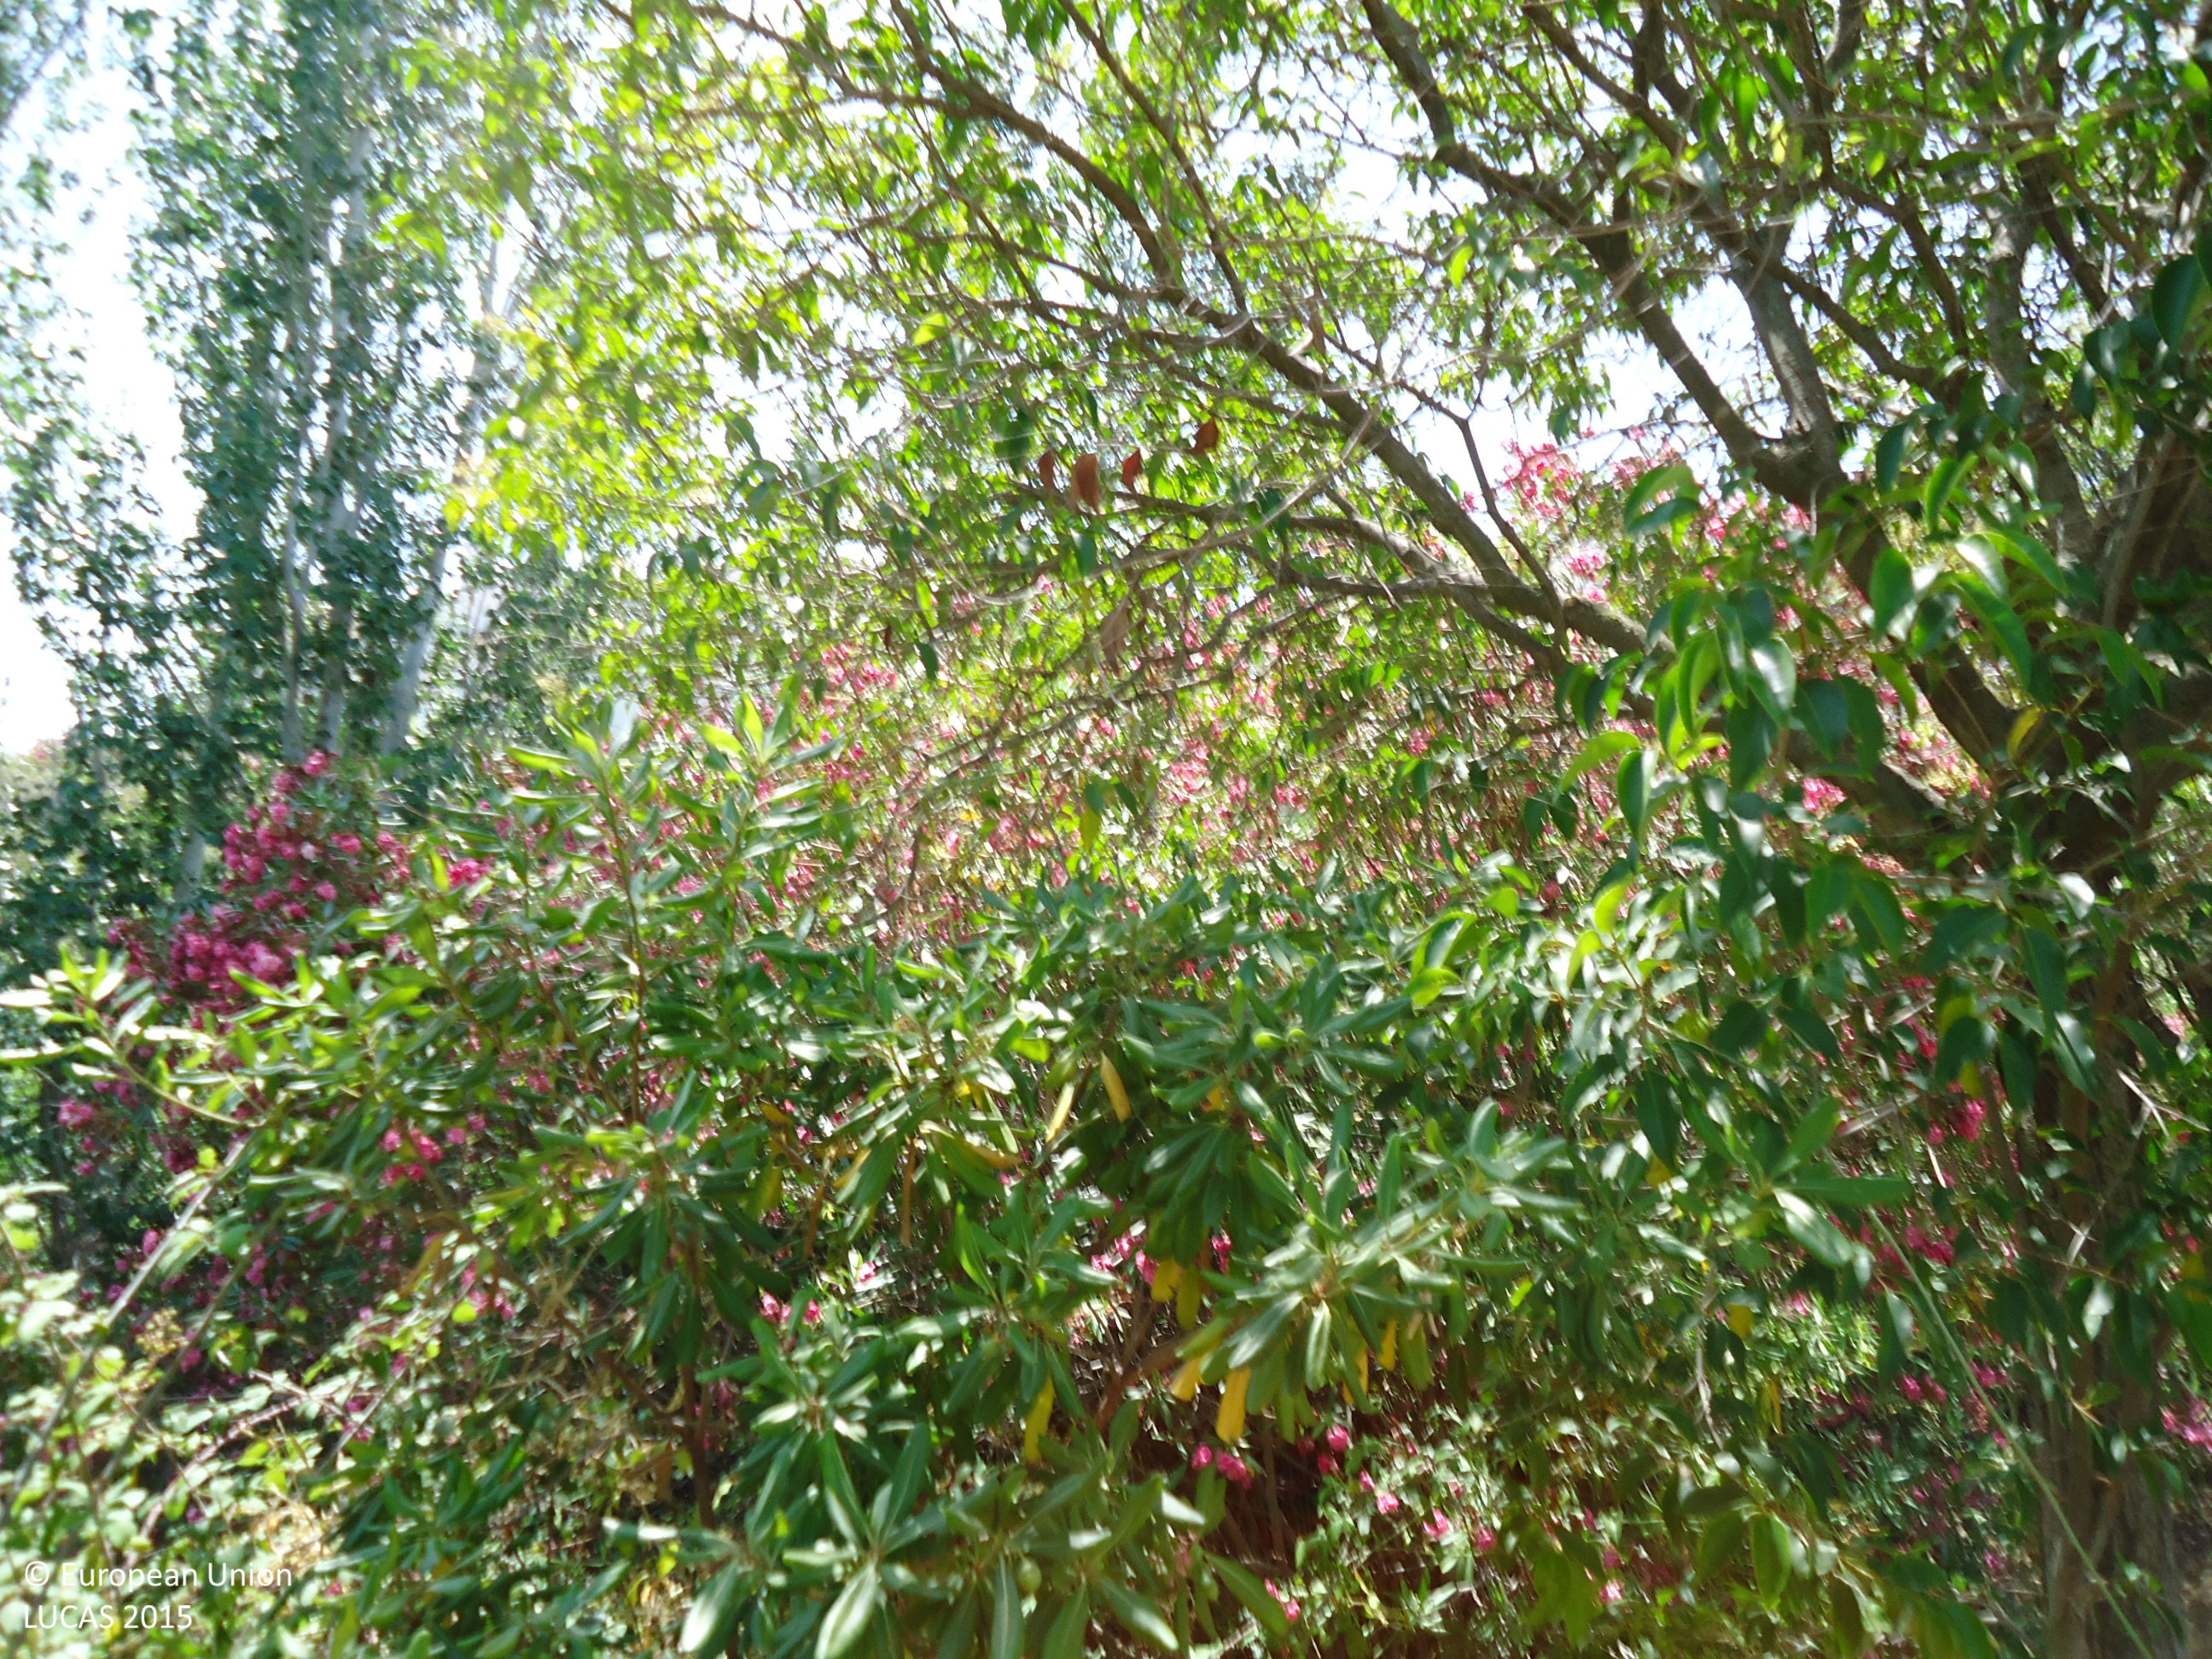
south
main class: Woodland
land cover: Broadleaved woodland
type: non-riverine alder, birch or aspen forest
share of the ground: > 75 %
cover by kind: broadleaved forest trees 95 %, shrubs 5 %
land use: Sport
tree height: > 5 m
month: July
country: ES
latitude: 36.5395
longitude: -4.7232
